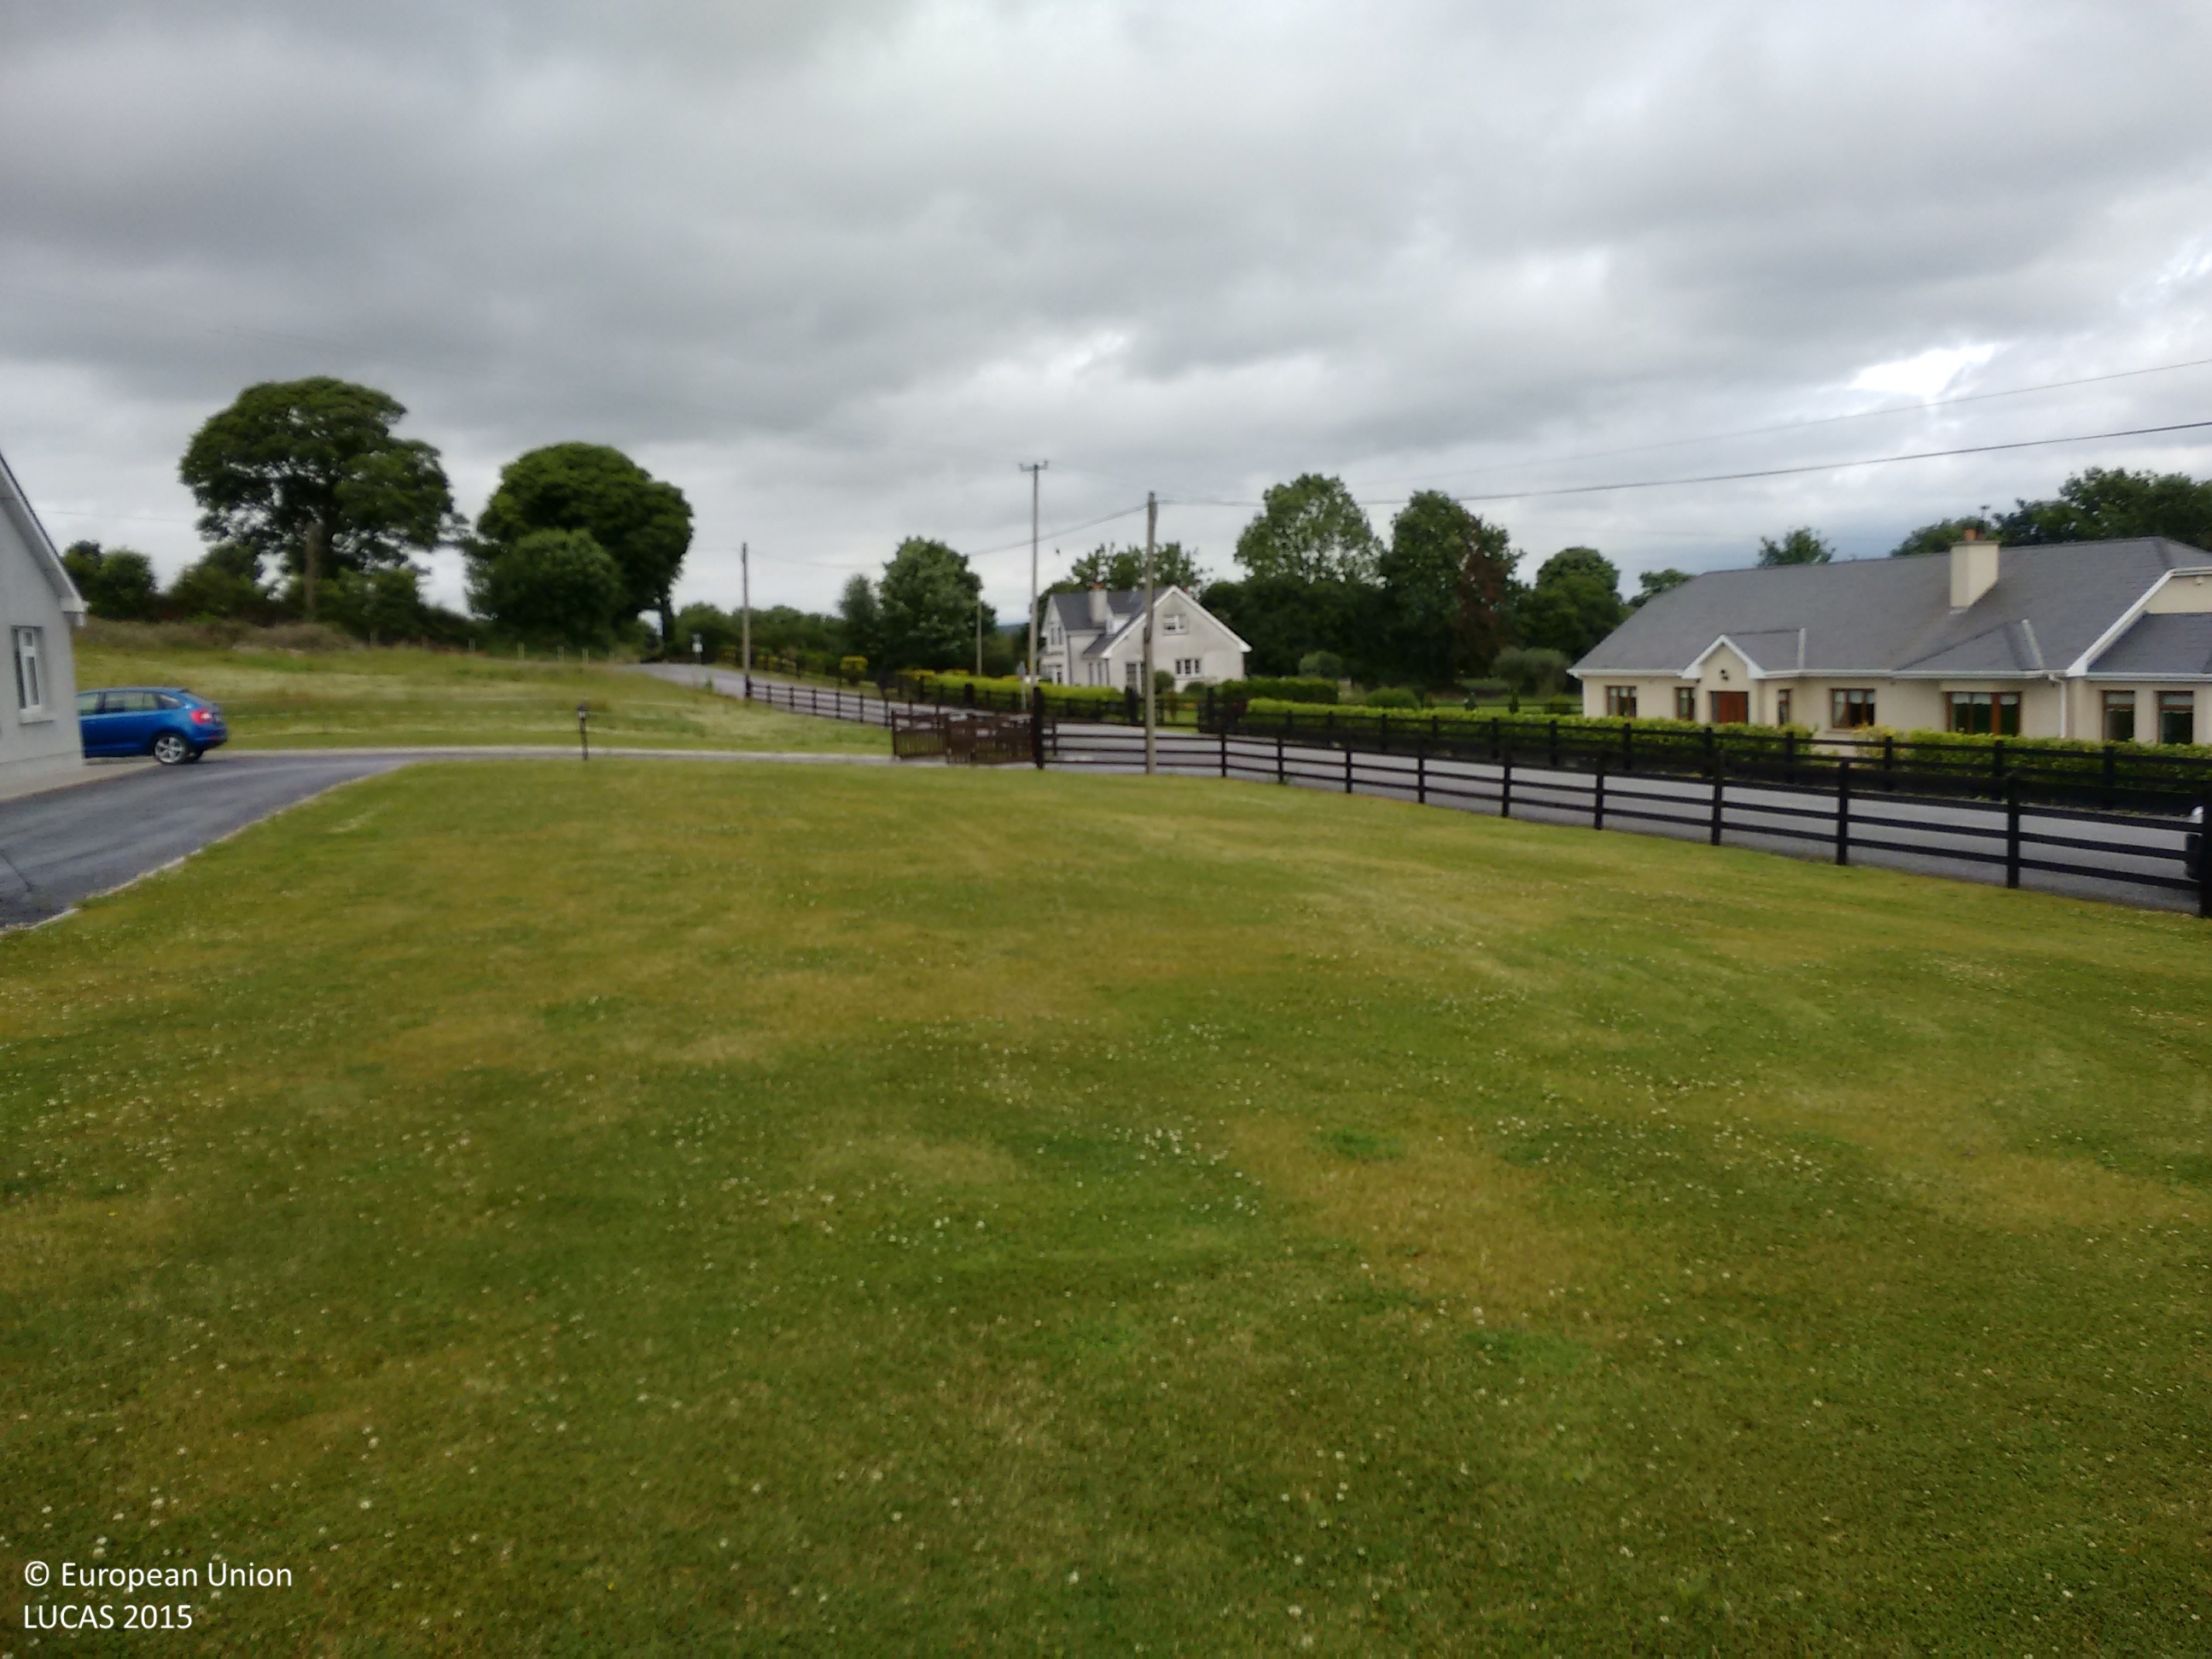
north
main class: Grassland
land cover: Grassland without tree/shrub cover
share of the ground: > 75 %
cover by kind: herbaceous plants 100 %
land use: Agriculture (excluding fallow land and kitchen gardens)
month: June
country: IE
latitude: 53.4368
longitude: -8.0136
